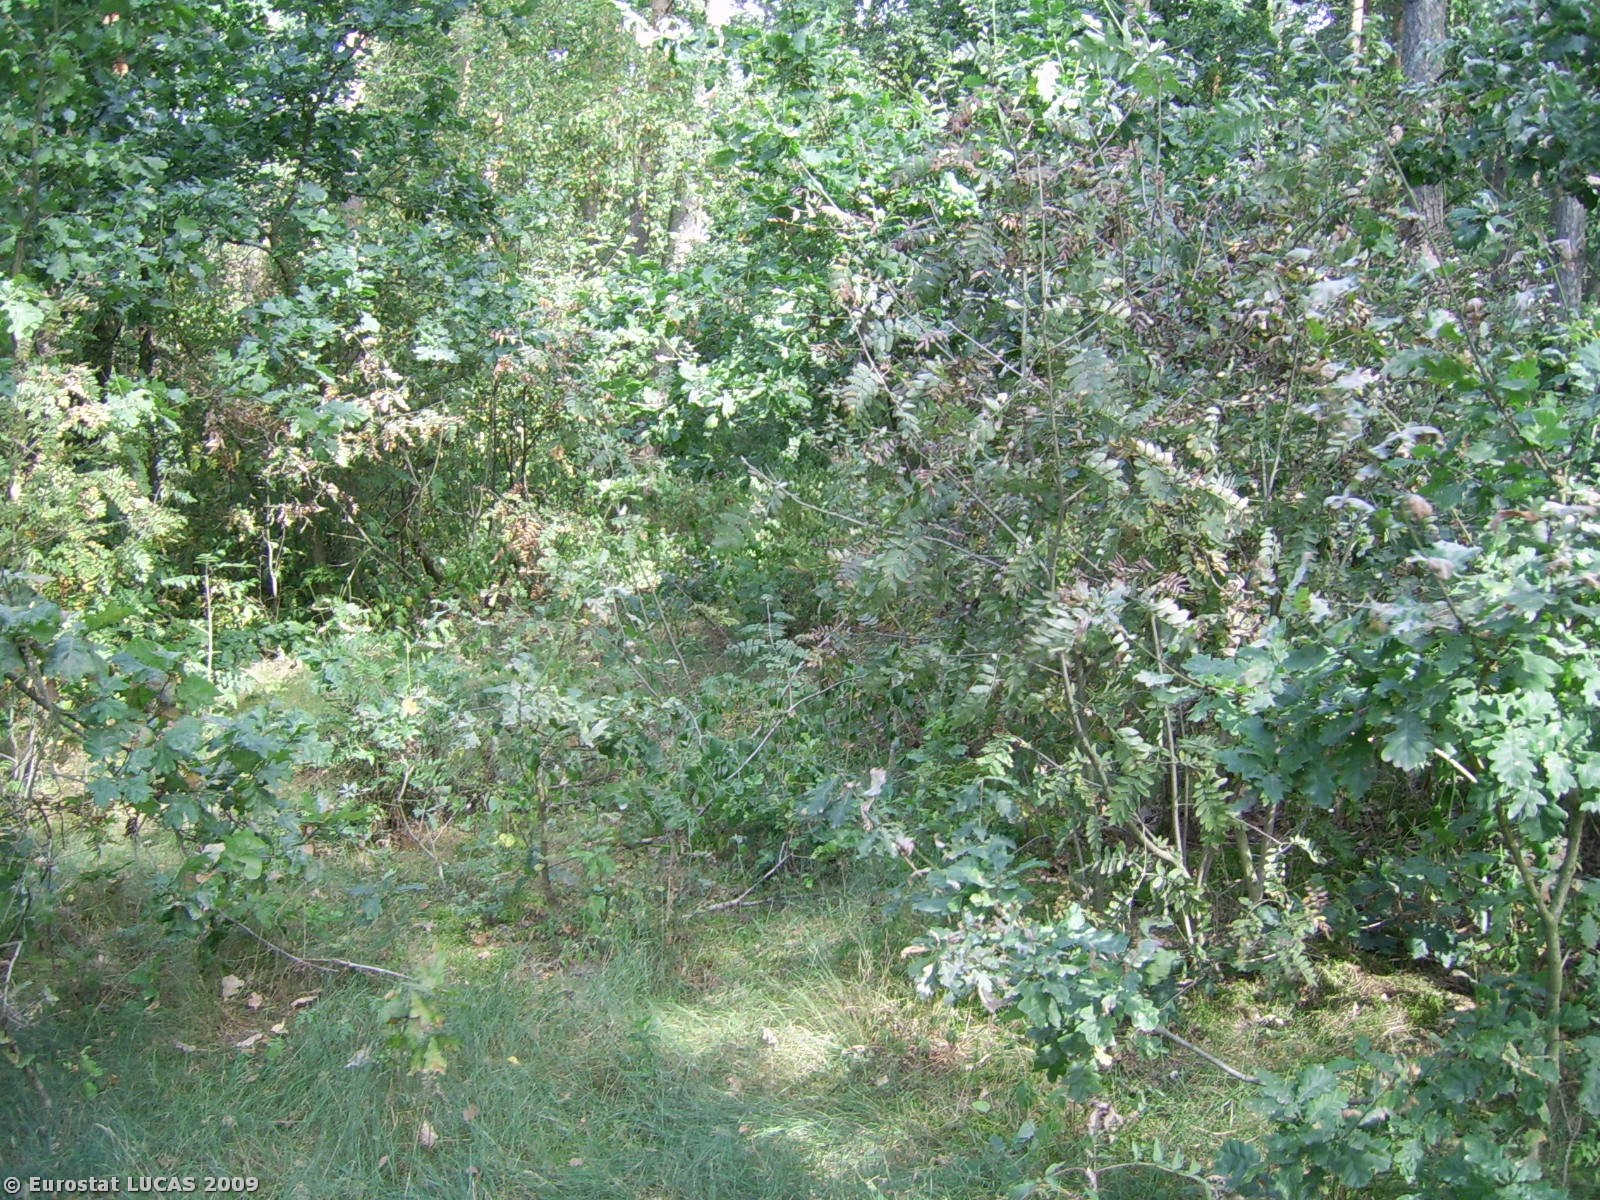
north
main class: Woodland
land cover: Coniferous woodland
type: hemiboreal forest and nemoral coniferous forest and mixed broadleaved-coniferous forest
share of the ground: > 75 %
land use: Unused
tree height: > 5 m
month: August
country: PL
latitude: 53.1379
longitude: 18.7654
